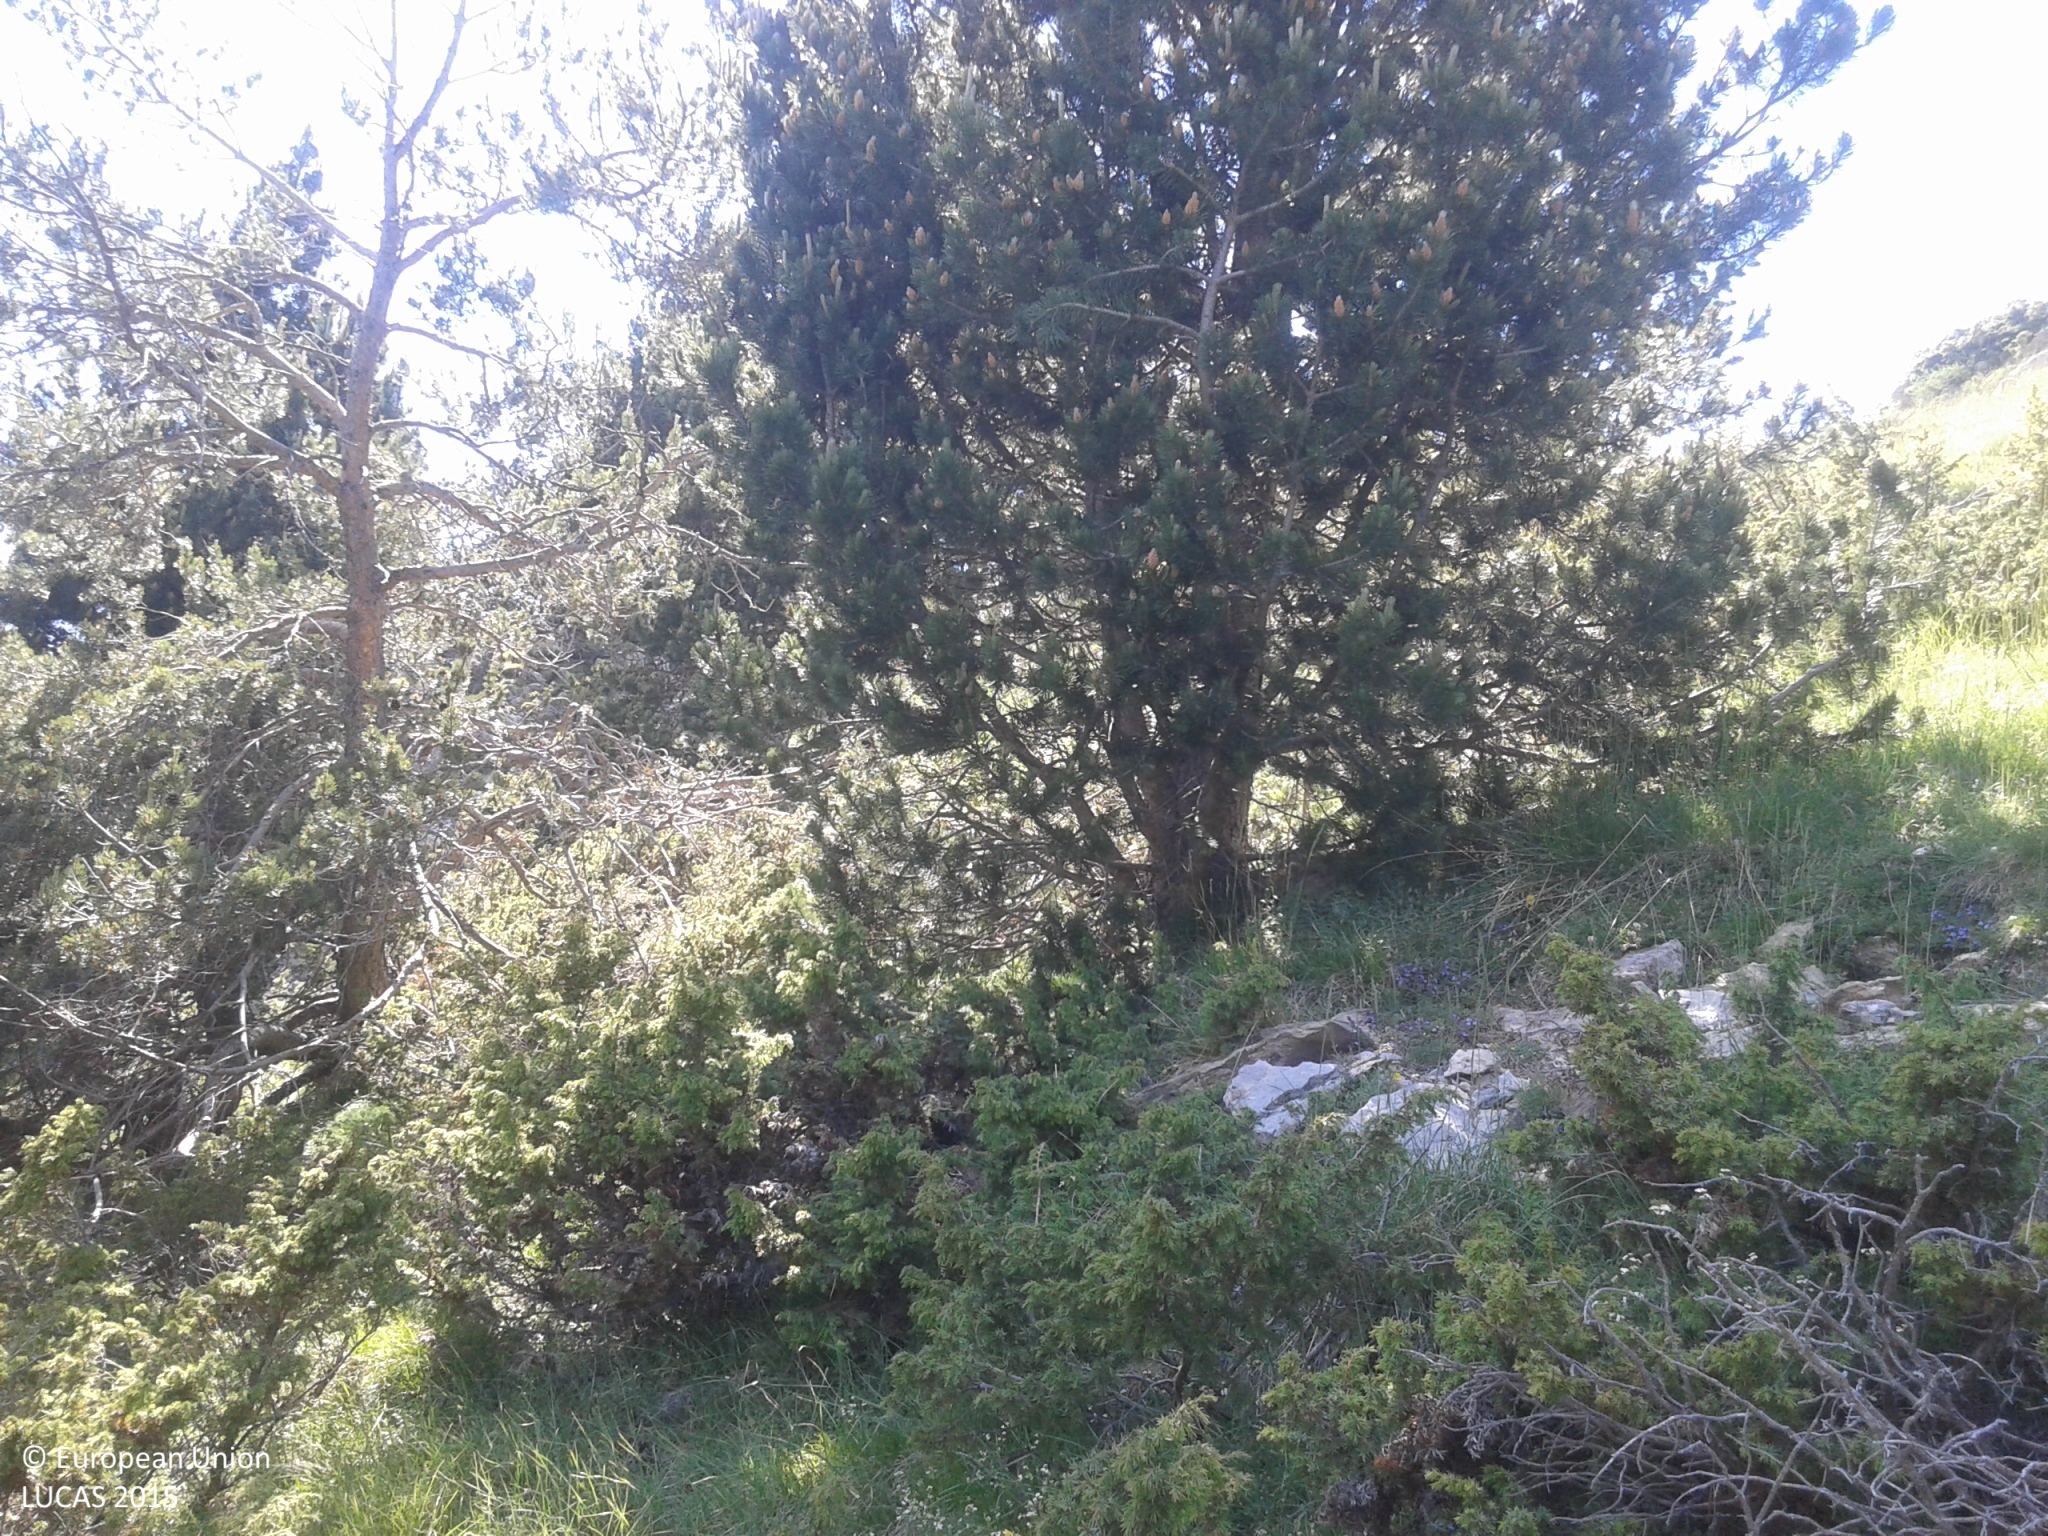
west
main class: Woodland
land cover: Pine dominated coniferous woodland
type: alpine coniferous forest
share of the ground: 25 - 50 %
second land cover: Grassland without tree/shrub cover
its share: 25 - 50 %
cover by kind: herbaceous plants 35 %, coniferous forest trees 30 %, shrubs 30 %, consolidated bare surface 5 %
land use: Agriculture (excluding fallow land and kitchen gardens)
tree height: > 5 m
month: June
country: ES
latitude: 42.4265
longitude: 1.5383
